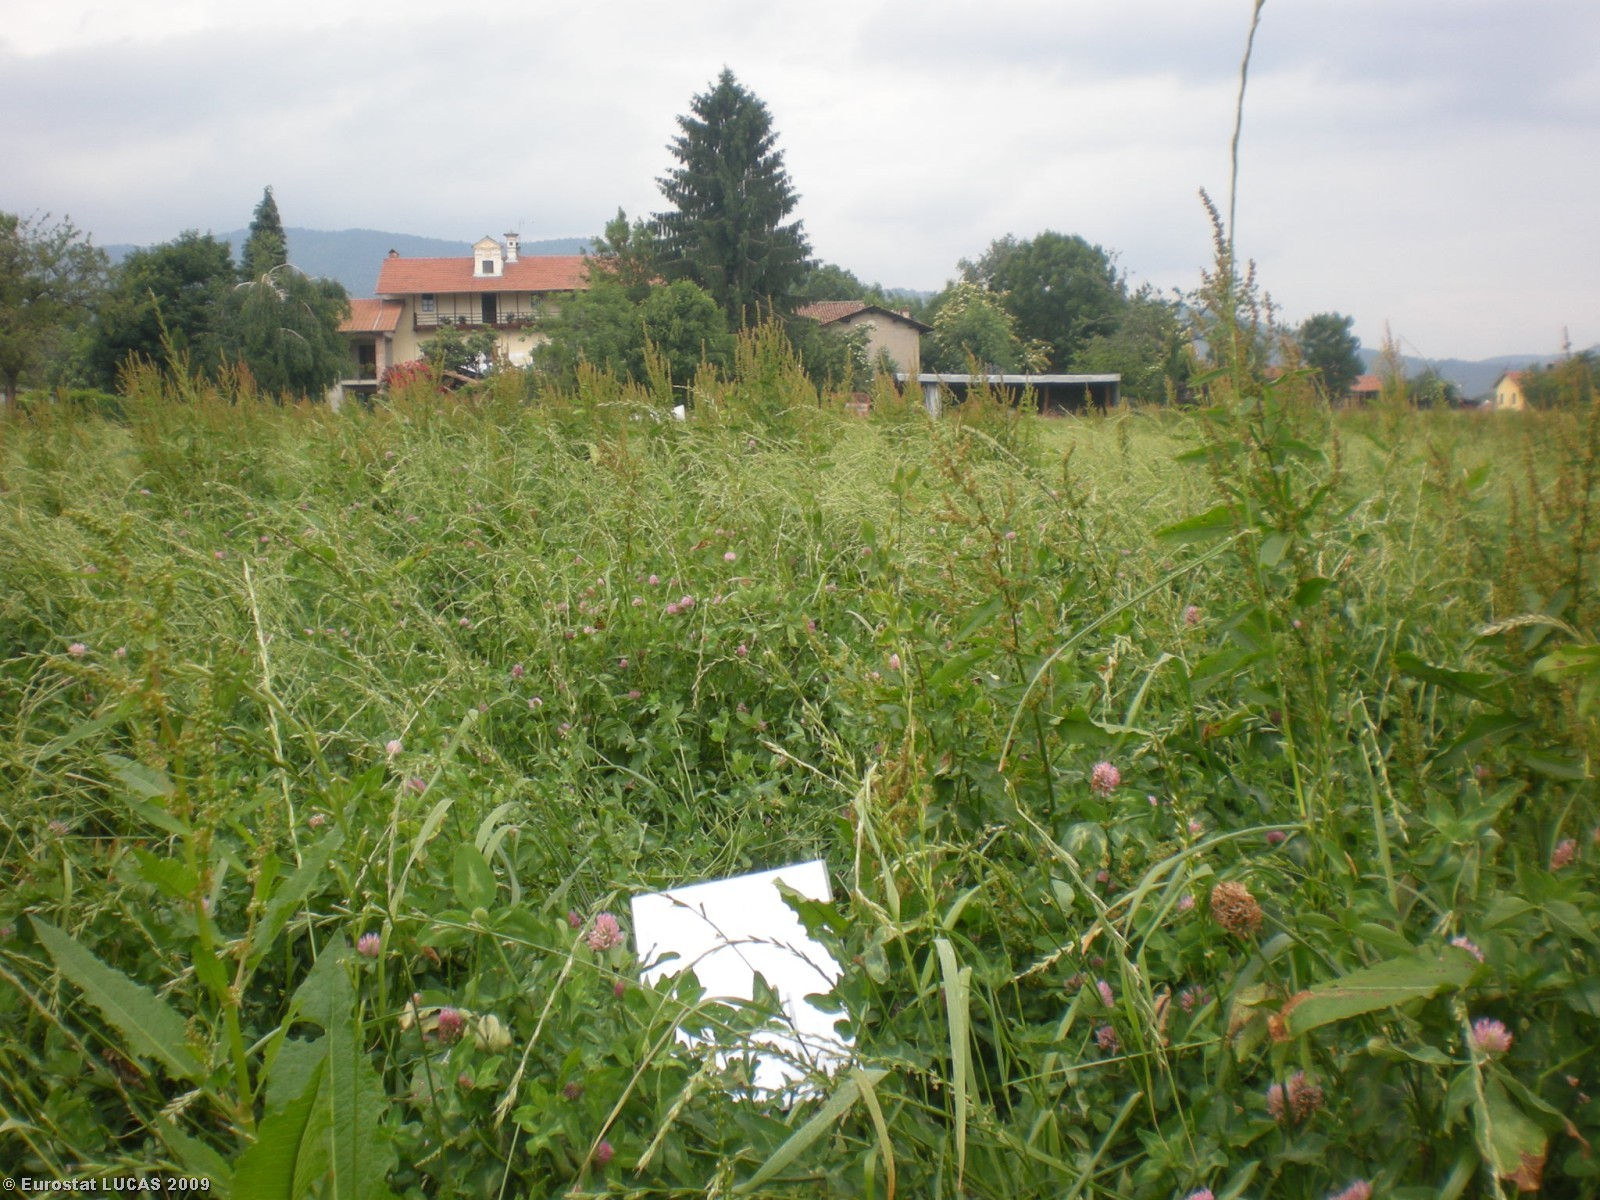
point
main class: Cropland
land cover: Other leguminous and mixtures for fodder
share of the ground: > 75 %
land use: Agriculture (excluding fallow land and kitchen gardens)
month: May
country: IT
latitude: 44.4631
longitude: 7.4286
